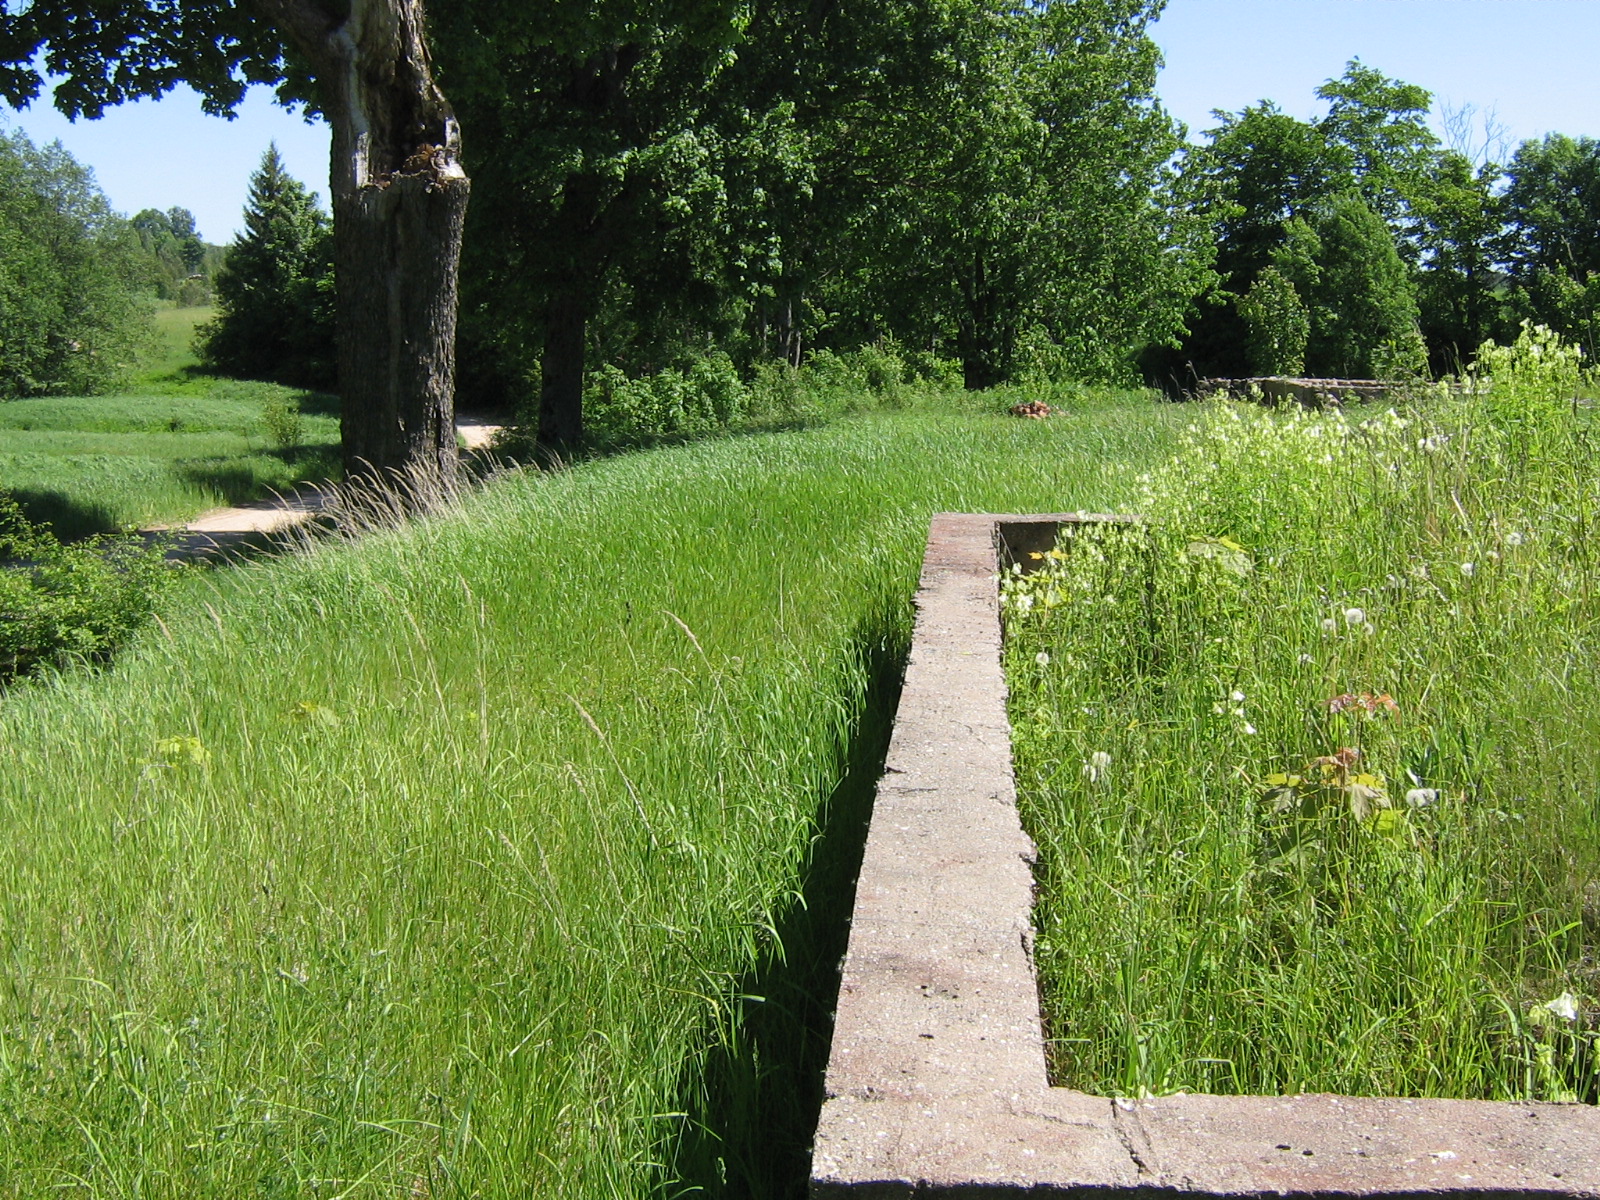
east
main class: Grassland
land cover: Spontaneously vegetated surfaces
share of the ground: > 75 %
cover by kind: herbaceous plants 95 %, shrubs 5 %
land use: Abandoned areas
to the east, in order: Spontaneously vegetated surfaces; Lines of trees; Spontaneously vegetated surfaces; Abandoned hedges; Paved roads, cycling and walking lanes; Grassland without tree/shrub cover; Ditches and canals; Grassland without tree/shrub cover; Paved roads, cycling and walking lanes; Grass margins; Other mixed woodland; Grassland without tree/shrub cover
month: June
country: LV
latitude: 57.1070
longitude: 25.8269
